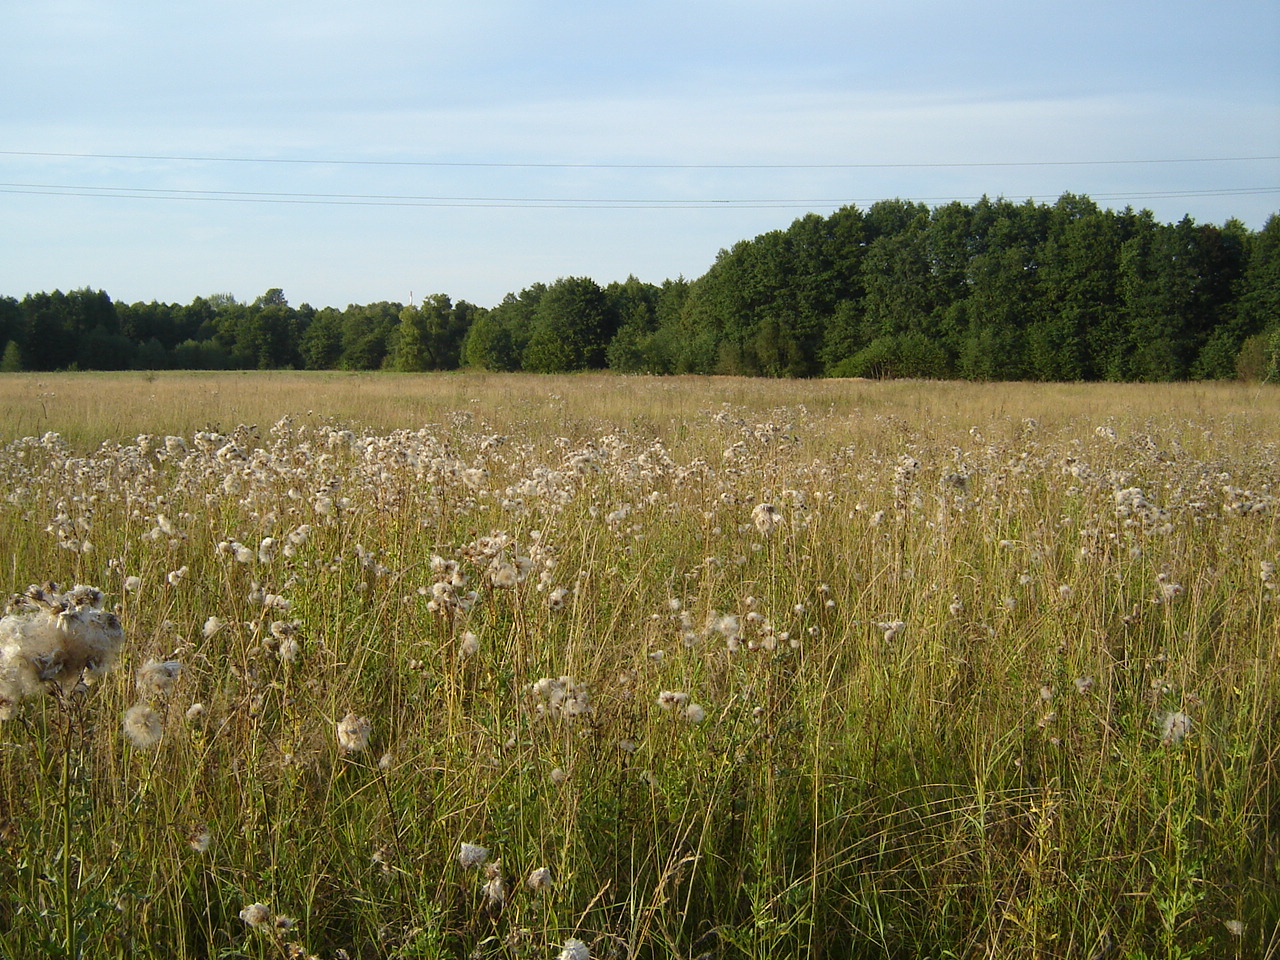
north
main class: Grassland
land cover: Spontaneously vegetated surfaces
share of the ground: > 75 %
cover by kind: herbaceous plants 100 %
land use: Fallow land
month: August
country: LT
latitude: 54.6025
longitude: 25.1495
